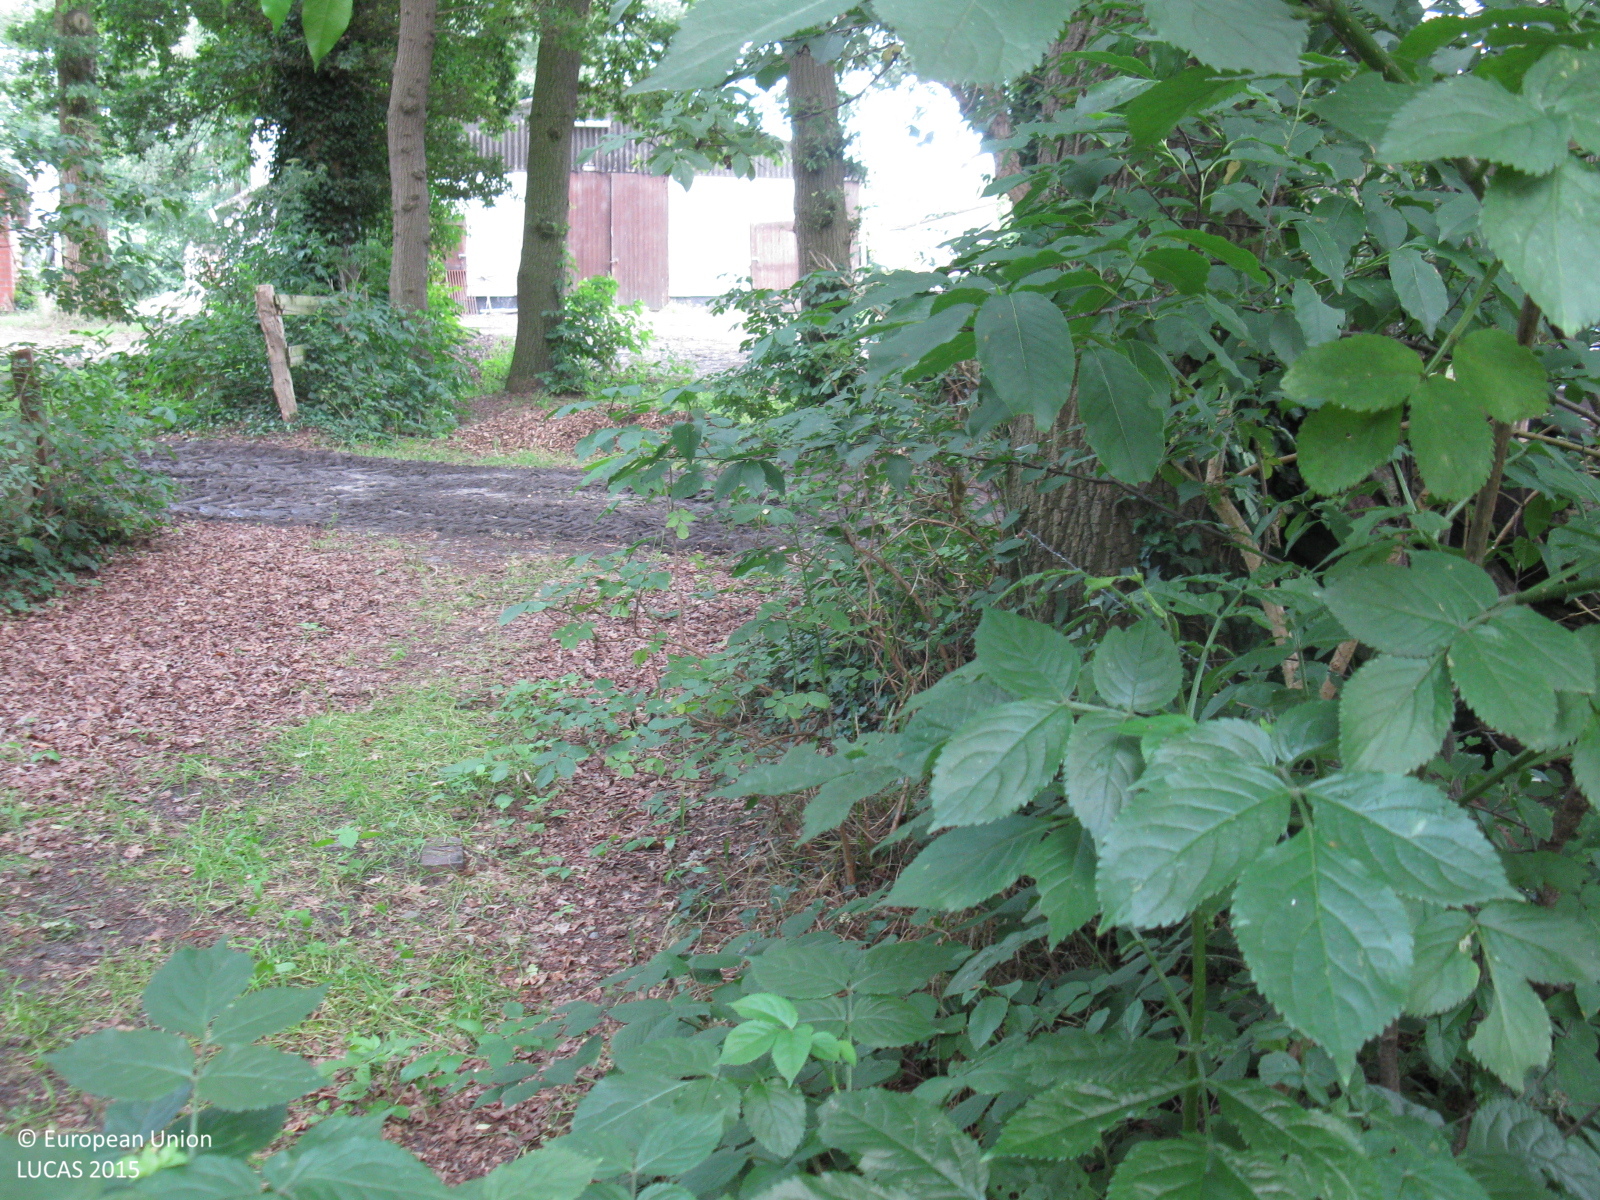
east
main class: Woodland
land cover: Broadleaved woodland
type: mesophytic deciduous forest
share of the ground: > 75 %
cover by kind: broadleaved forest trees 100 %
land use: Semi-natural and natural areas not in use
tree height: > 5 m
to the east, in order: Broadleaved woodland; Artificial constructions in urban areas; Maize; Grassland with sparse tree/shrub cover; Barley
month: July
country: DE
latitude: 53.0241
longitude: 7.8984
